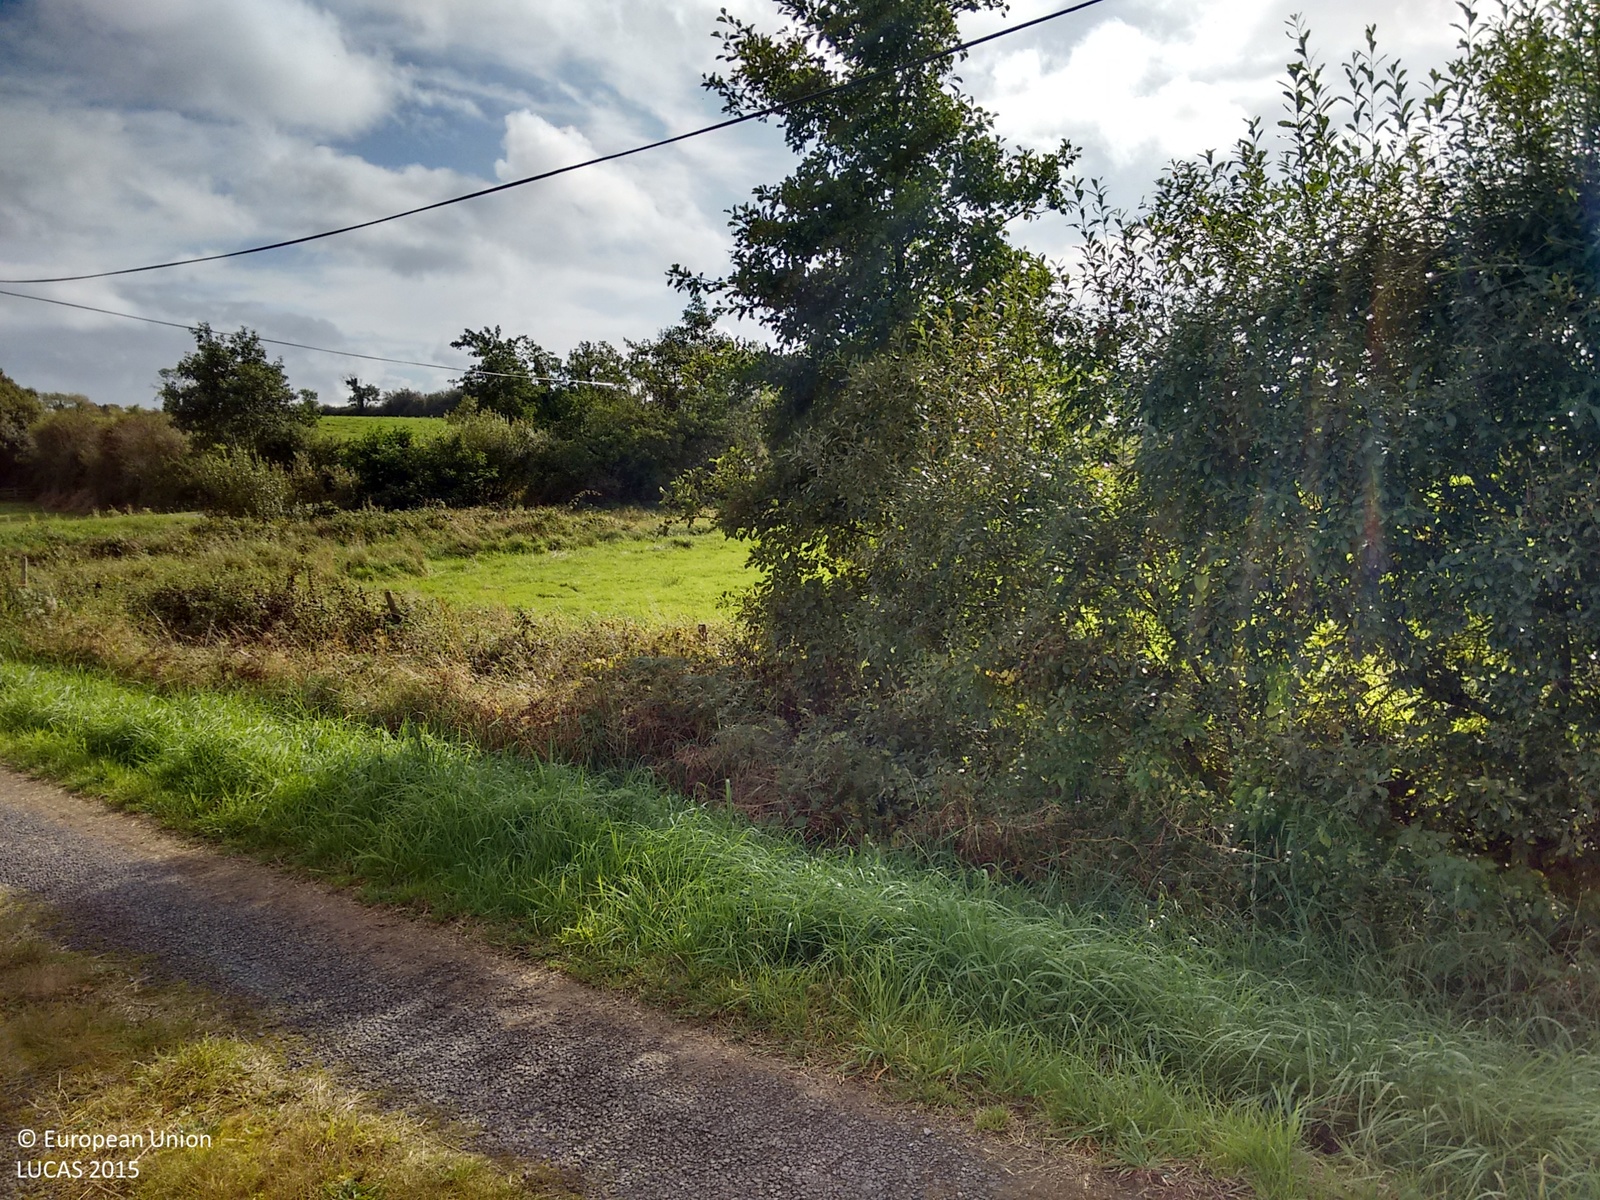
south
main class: Grassland
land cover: Grassland without tree/shrub cover
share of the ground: > 75 %
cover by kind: herbaceous plants 100 %
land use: Agriculture (excluding fallow land and kitchen gardens)
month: October
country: IE
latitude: 53.8358
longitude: -8.0623
